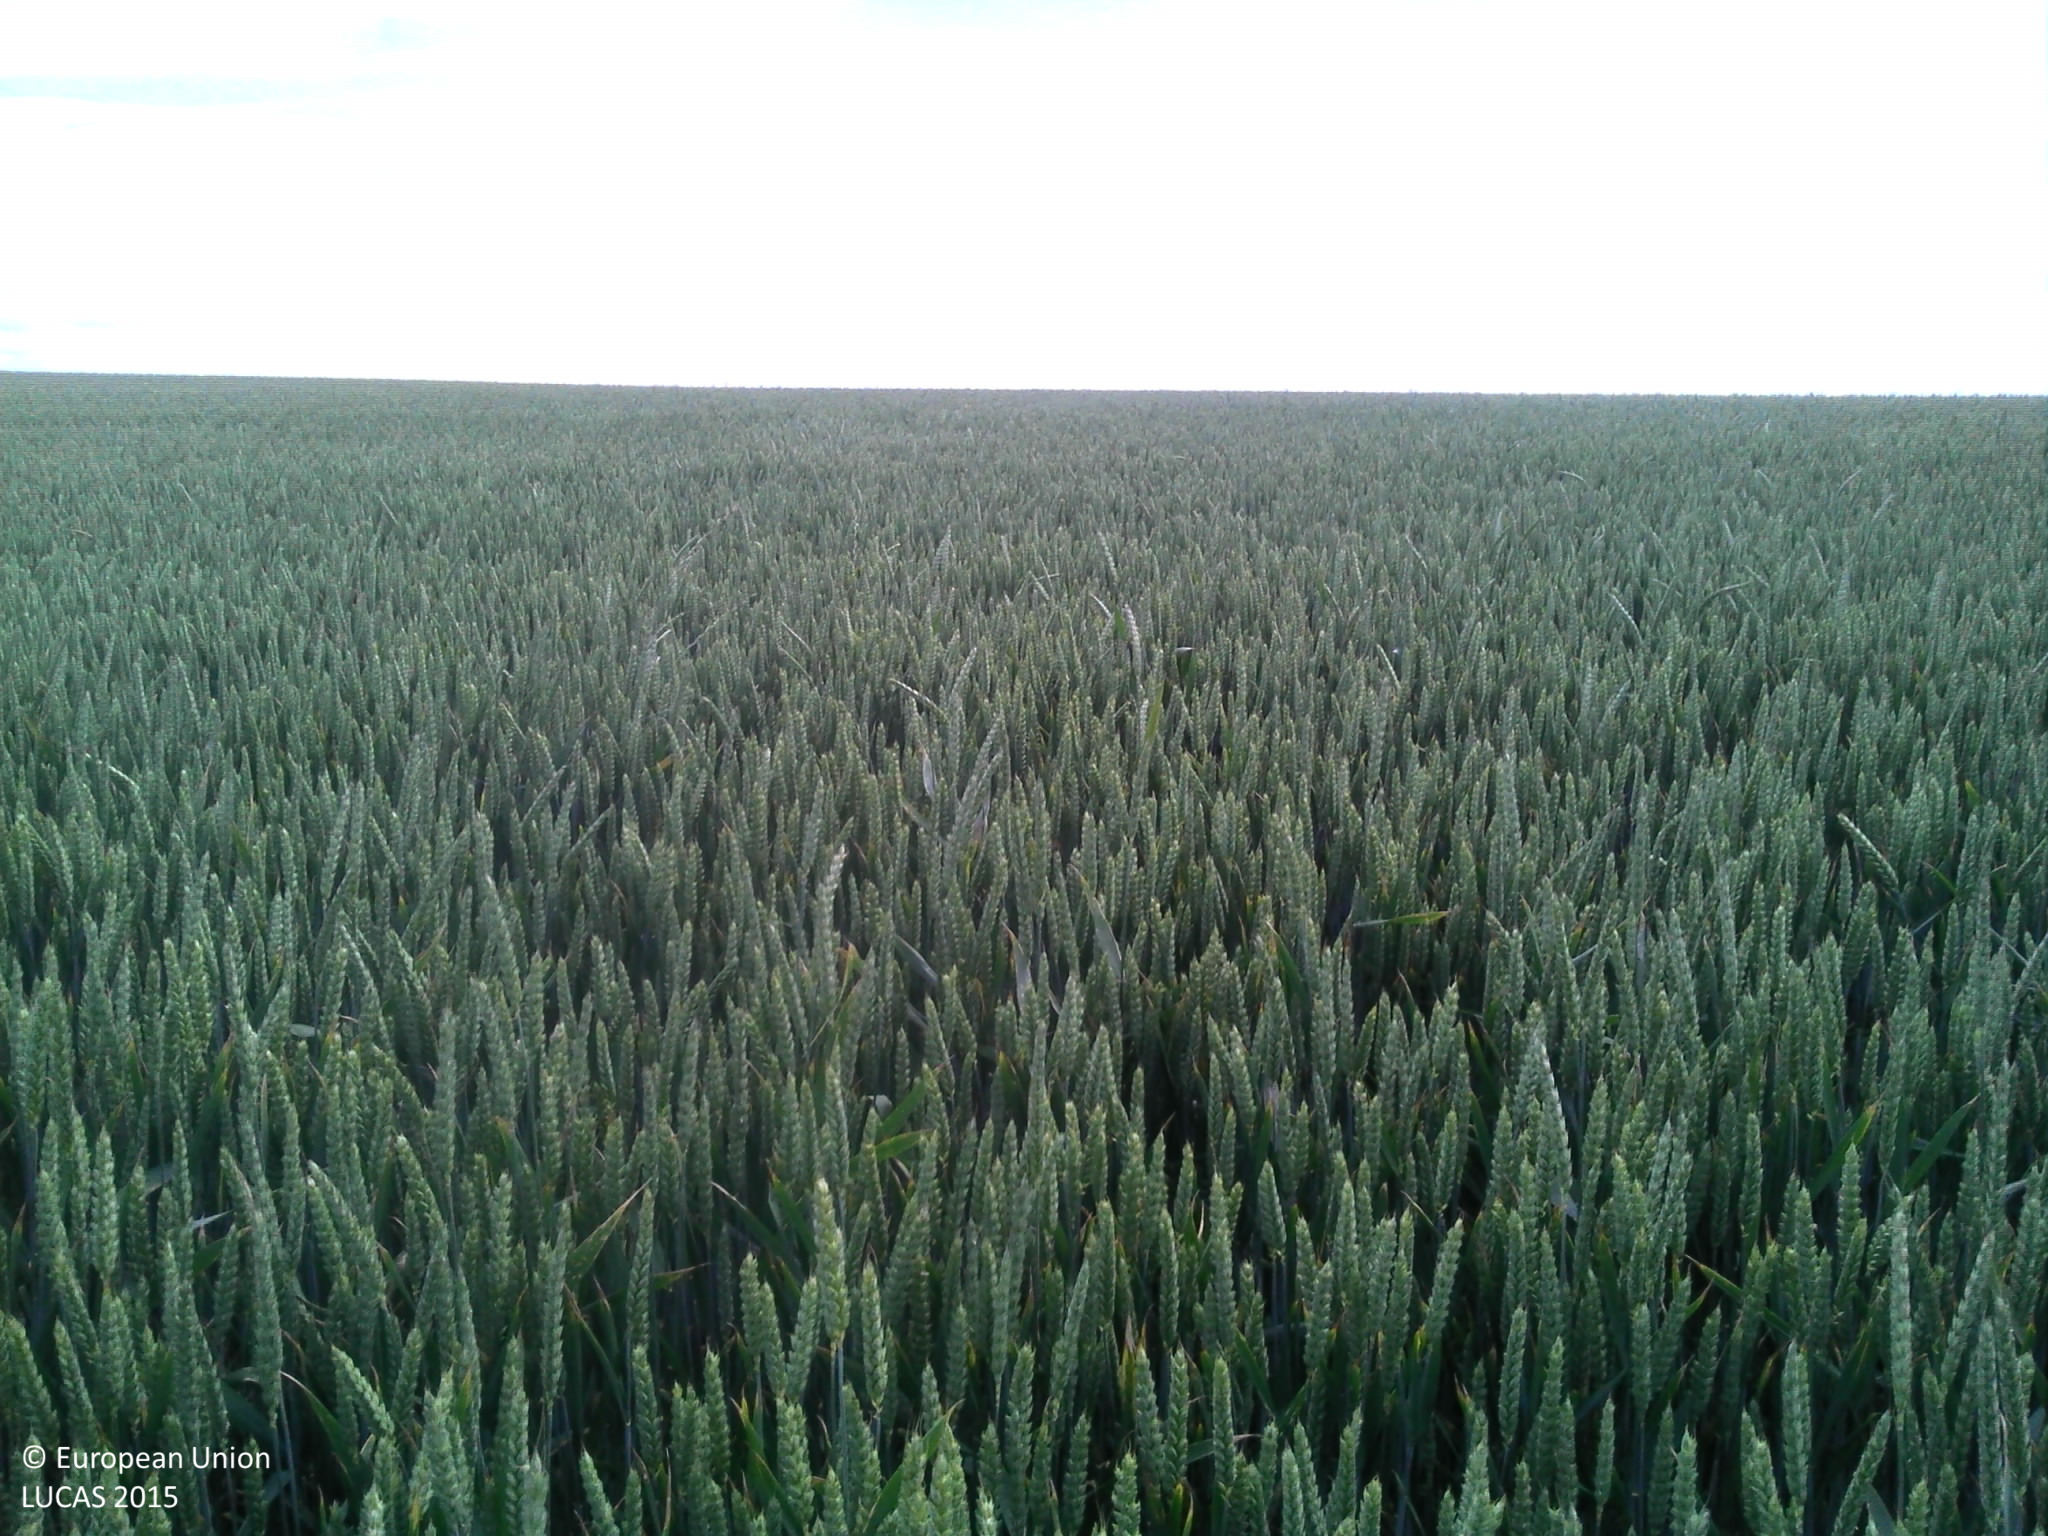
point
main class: Cropland
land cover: Common wheat
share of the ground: > 75 %
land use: Agriculture (excluding fallow land and kitchen gardens)
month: June
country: FR
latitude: 49.6780
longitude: 2.4067
